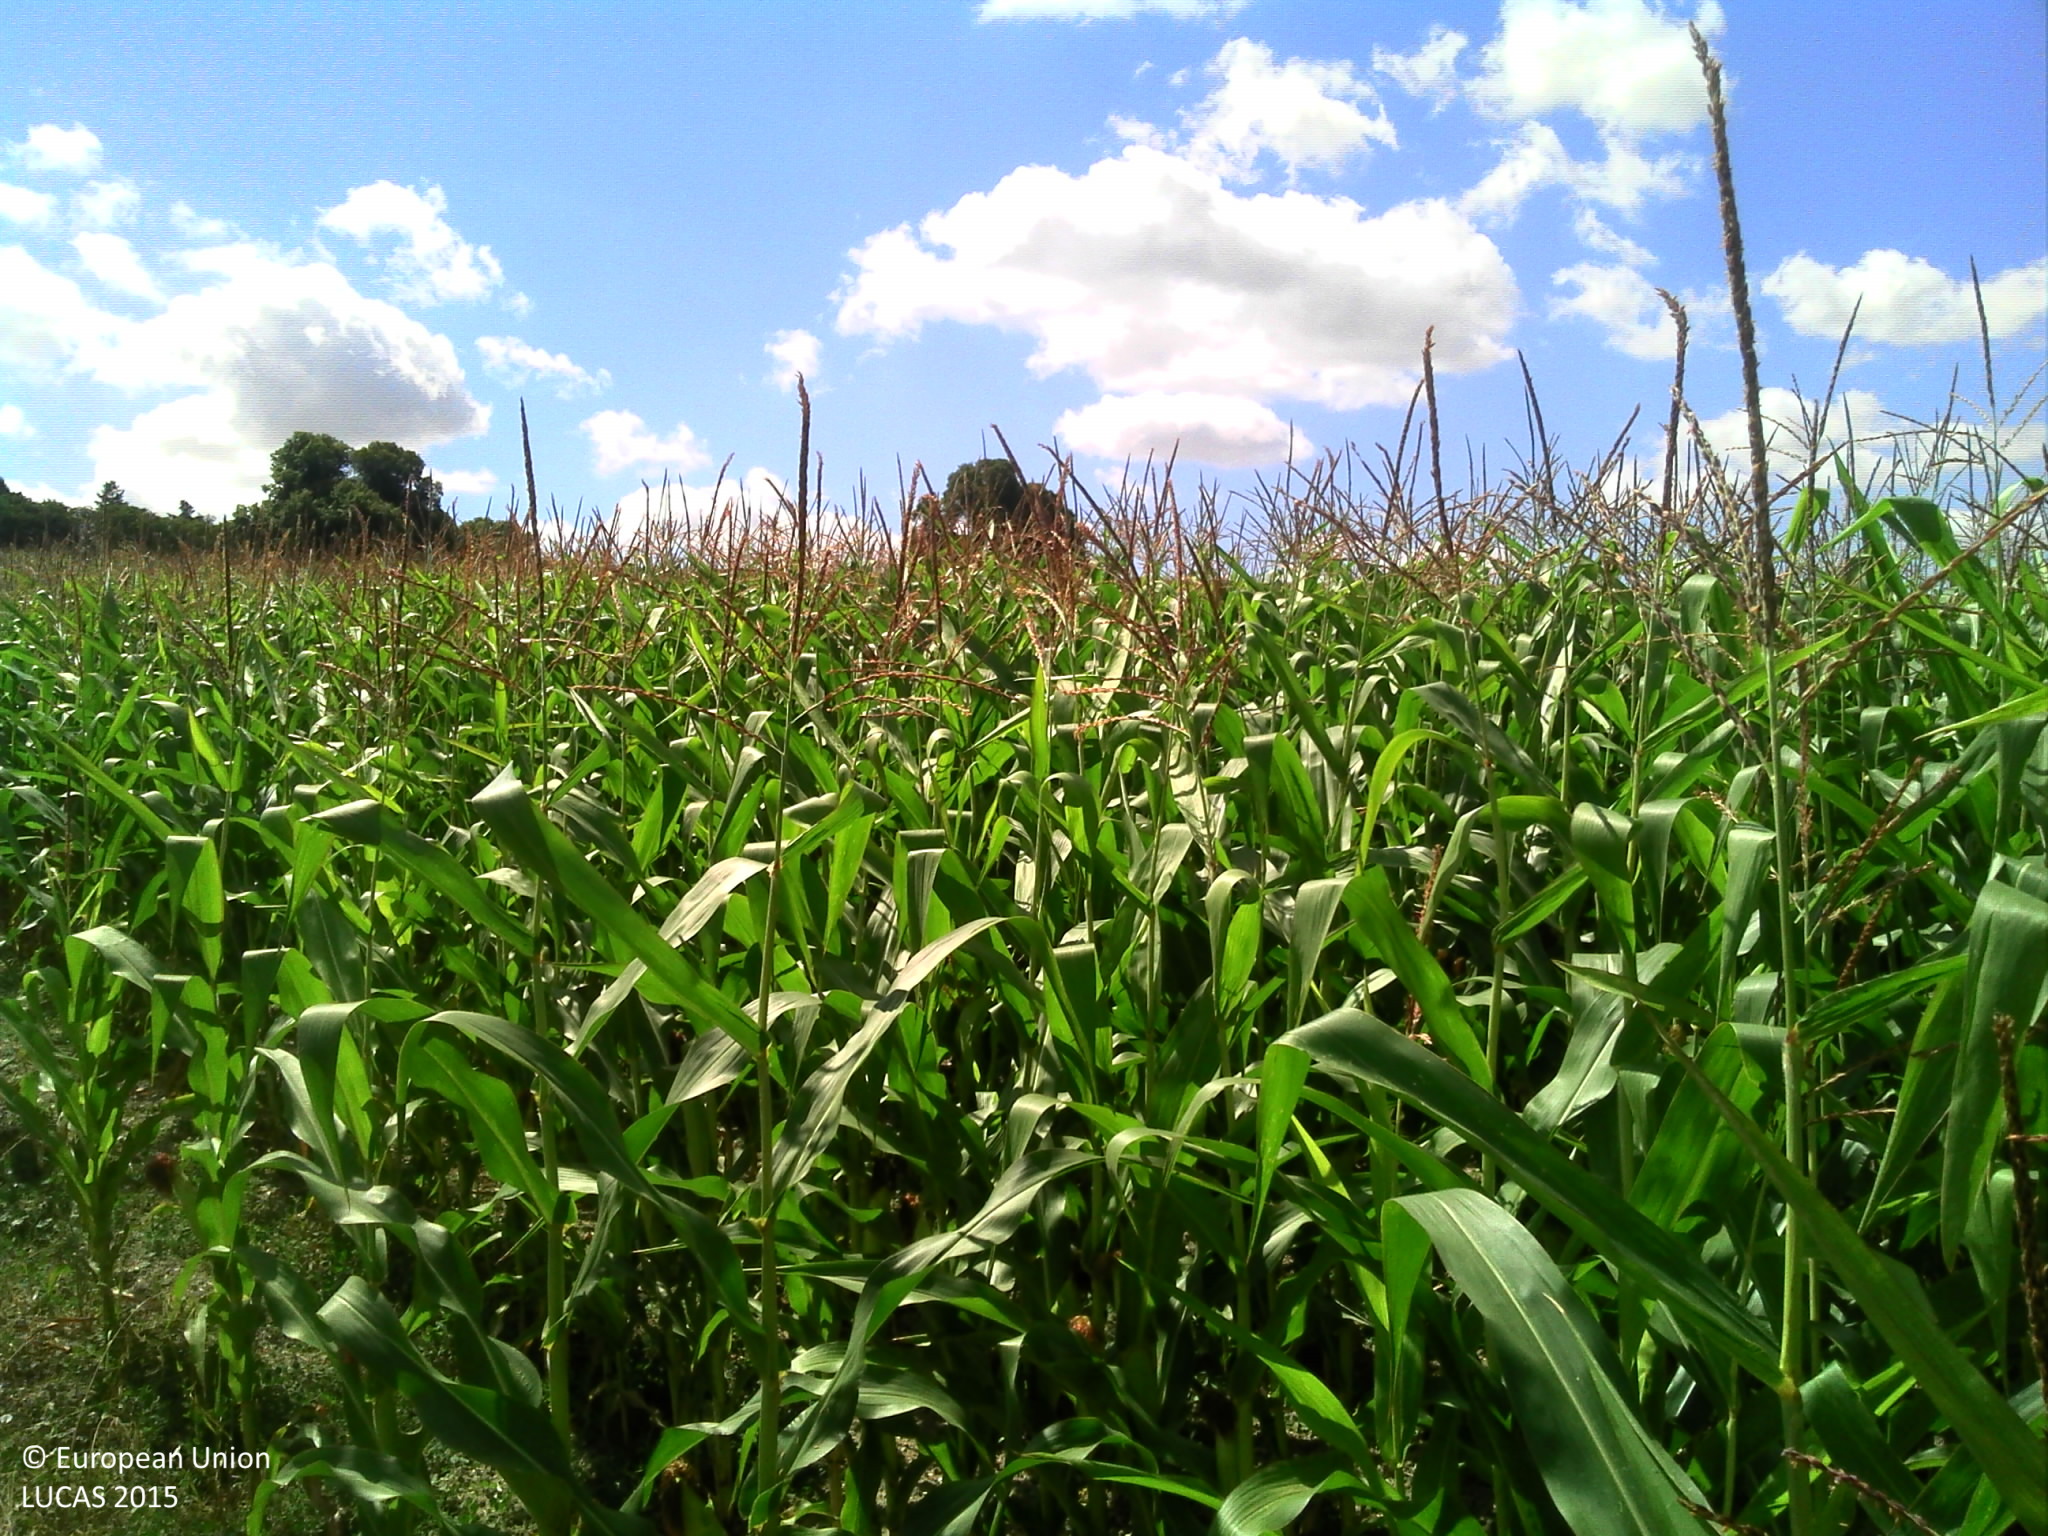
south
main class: Cropland
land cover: Maize
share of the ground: > 75 %
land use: Agriculture (excluding fallow land and kitchen gardens)
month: July
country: FR
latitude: 47.0257
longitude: 0.4142
